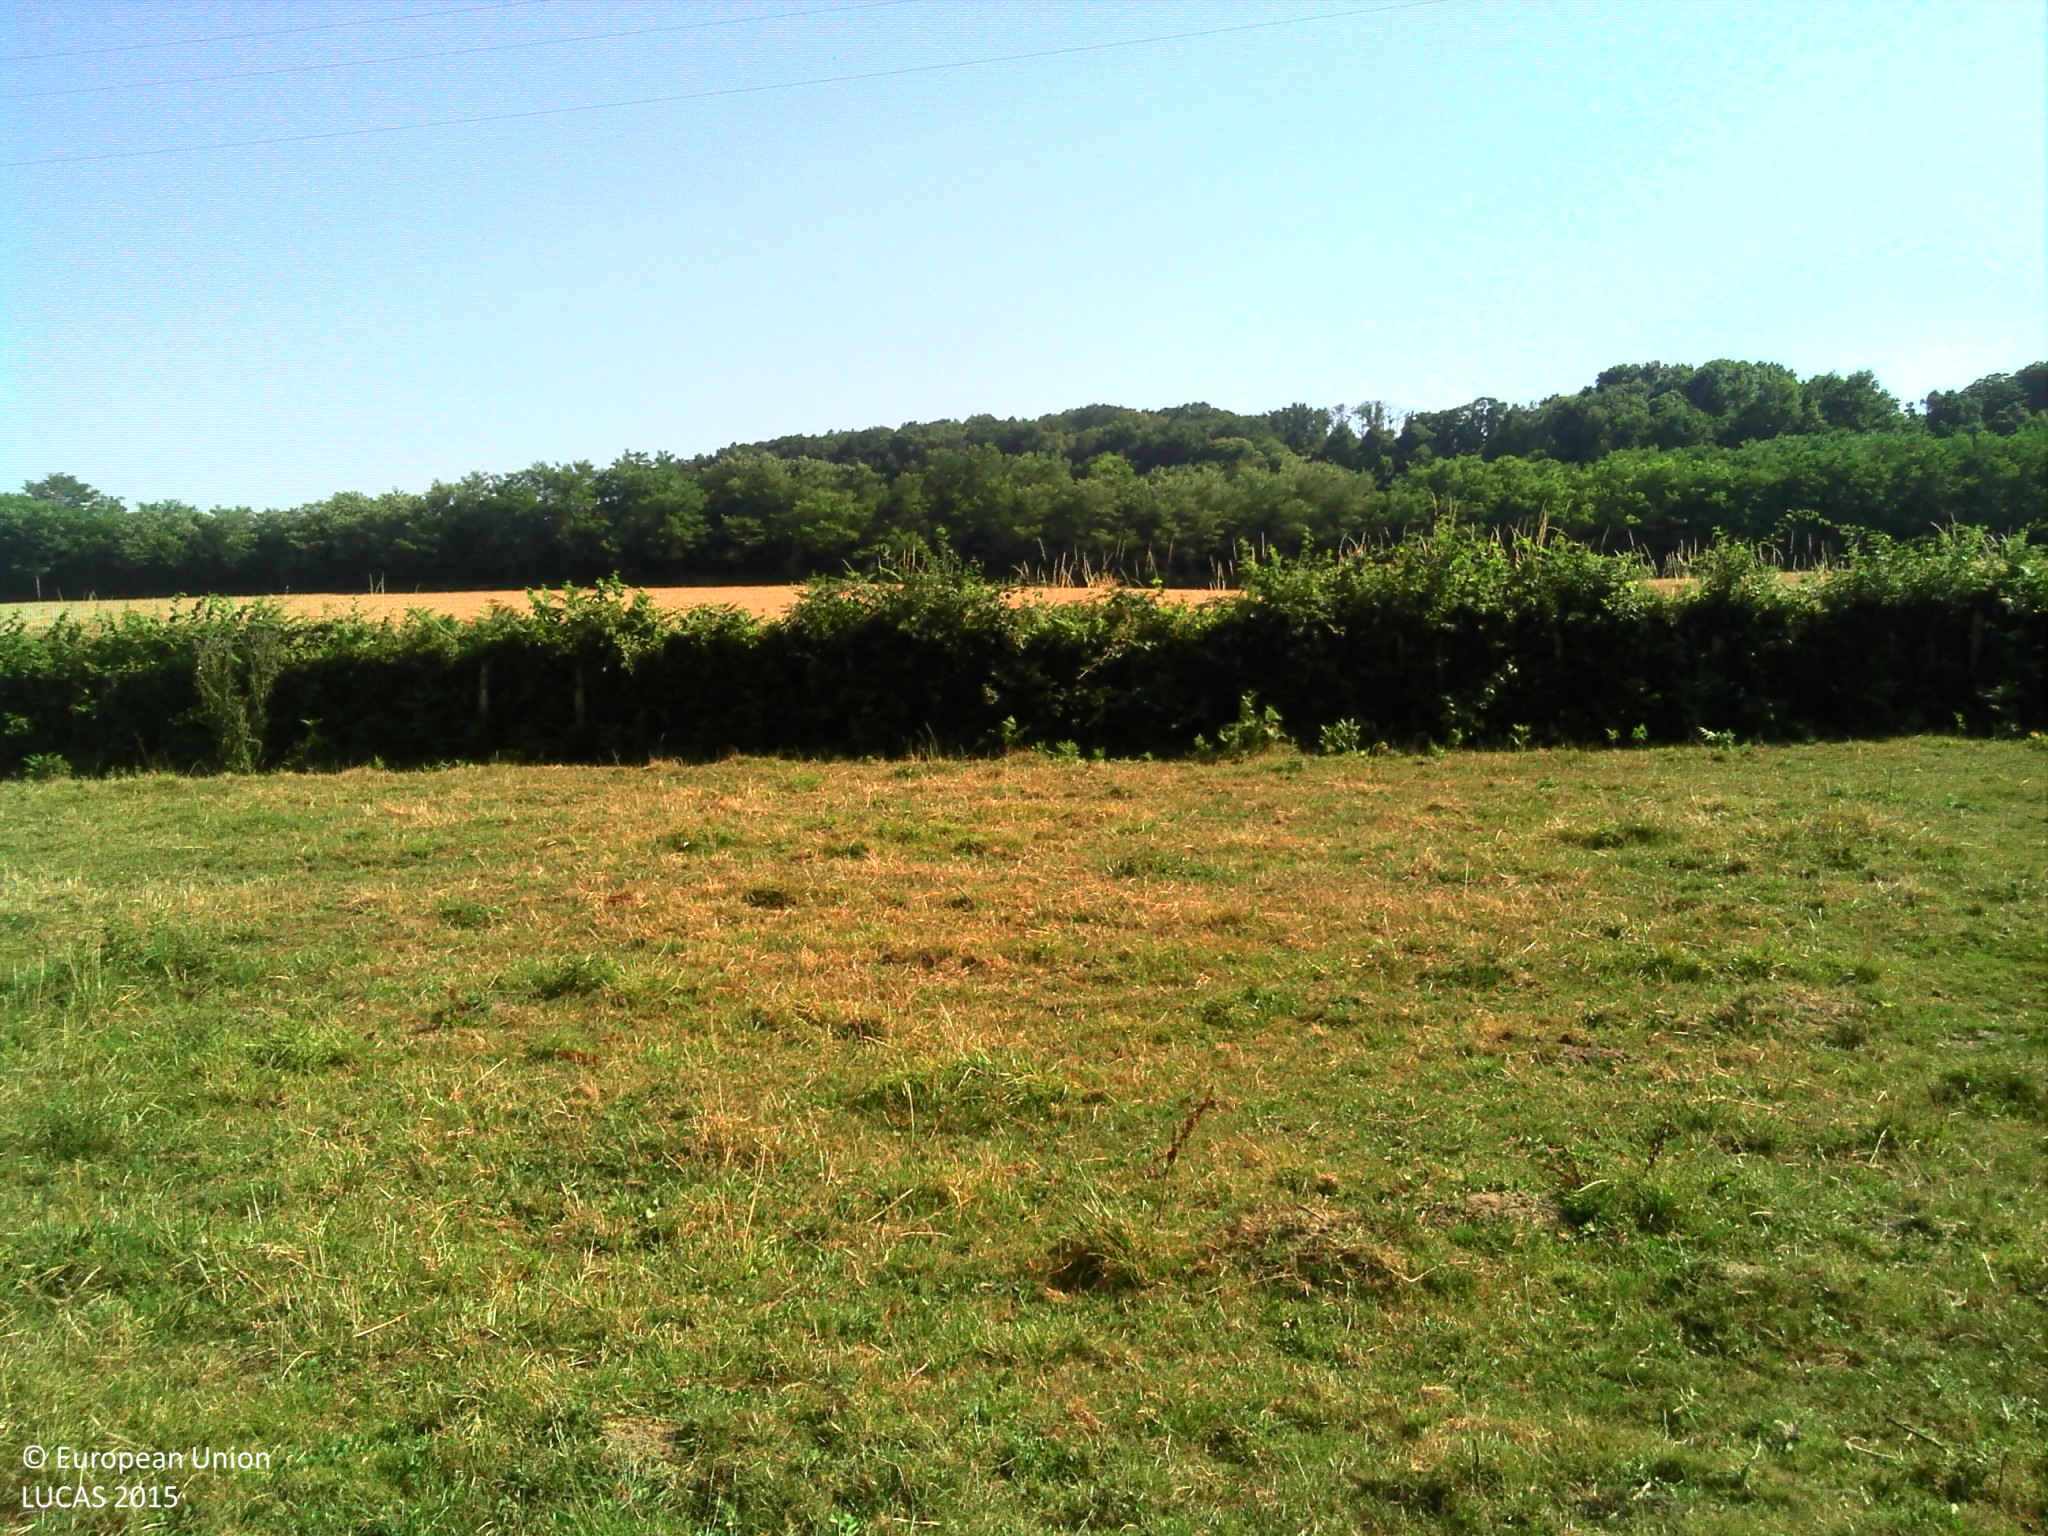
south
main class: Grassland
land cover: Grassland without tree/shrub cover
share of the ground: > 75 %
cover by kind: herbaceous plants 95 %, shrubs 5 %
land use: Agriculture (excluding fallow land and kitchen gardens)
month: July
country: FR
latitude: 46.1384
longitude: 1.7207
